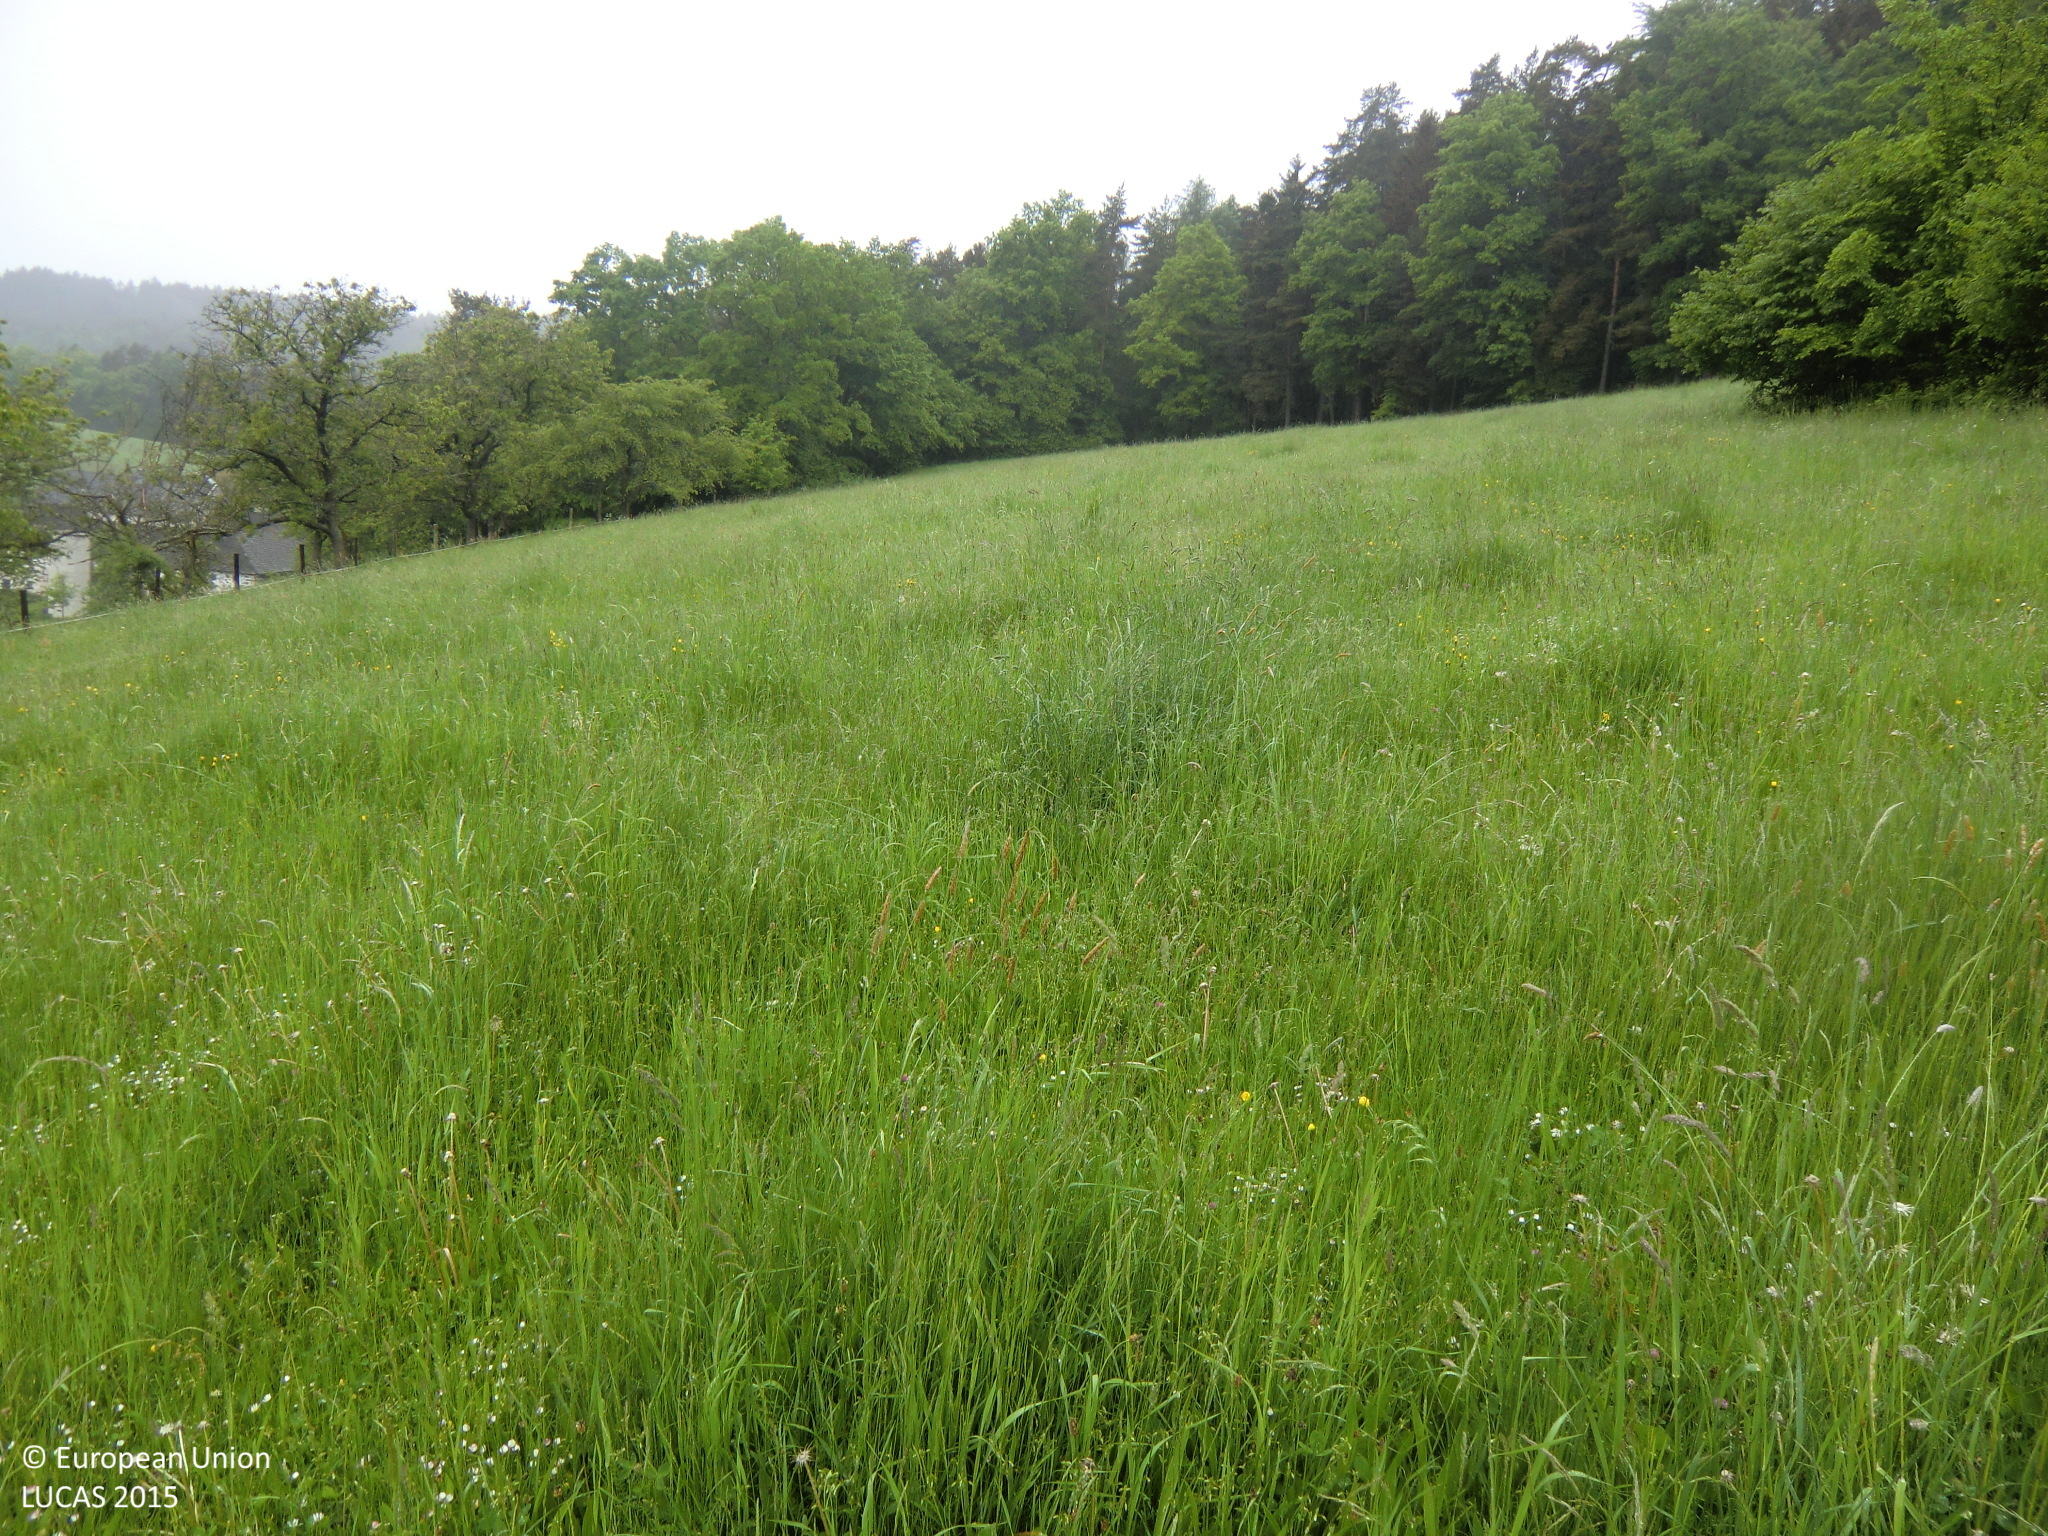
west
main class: Grassland
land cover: Grassland without tree/shrub cover
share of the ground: > 75 %
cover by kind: herbaceous plants 100 %
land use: Agriculture (excluding fallow land and kitchen gardens)
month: May
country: AT
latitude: 48.4233
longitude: 14.4193
